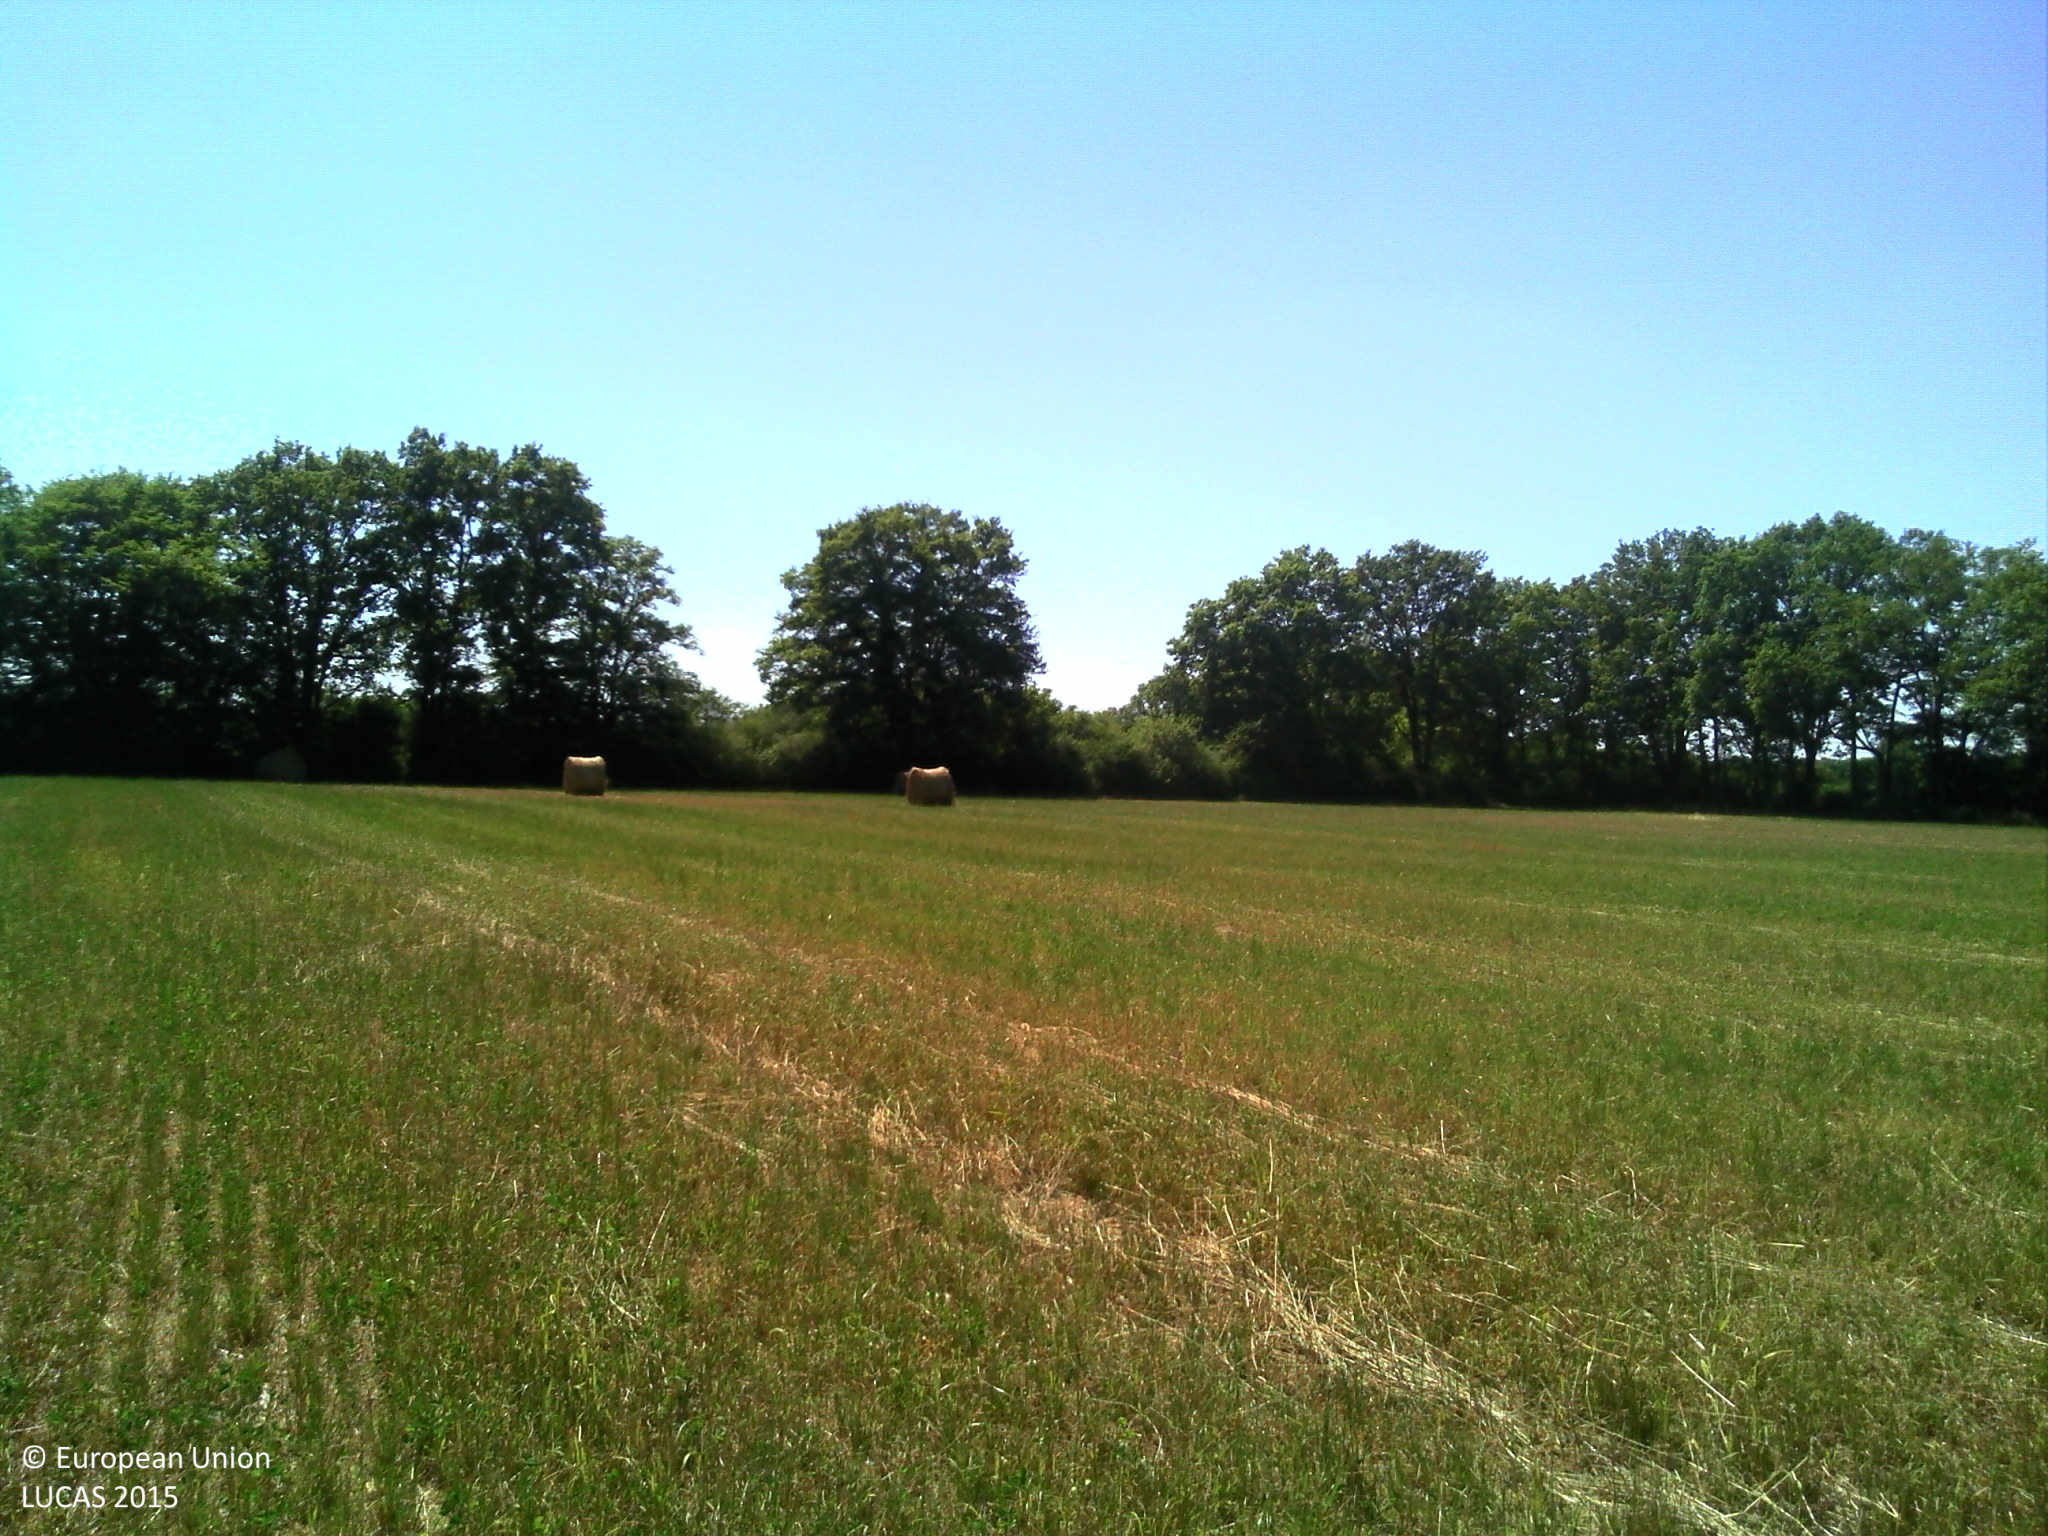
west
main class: Grassland
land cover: Grassland without tree/shrub cover
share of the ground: > 75 %
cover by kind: herbaceous plants 100 %
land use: Agriculture (excluding fallow land and kitchen gardens)
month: June
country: FR
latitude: 47.6494
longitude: 2.8709
